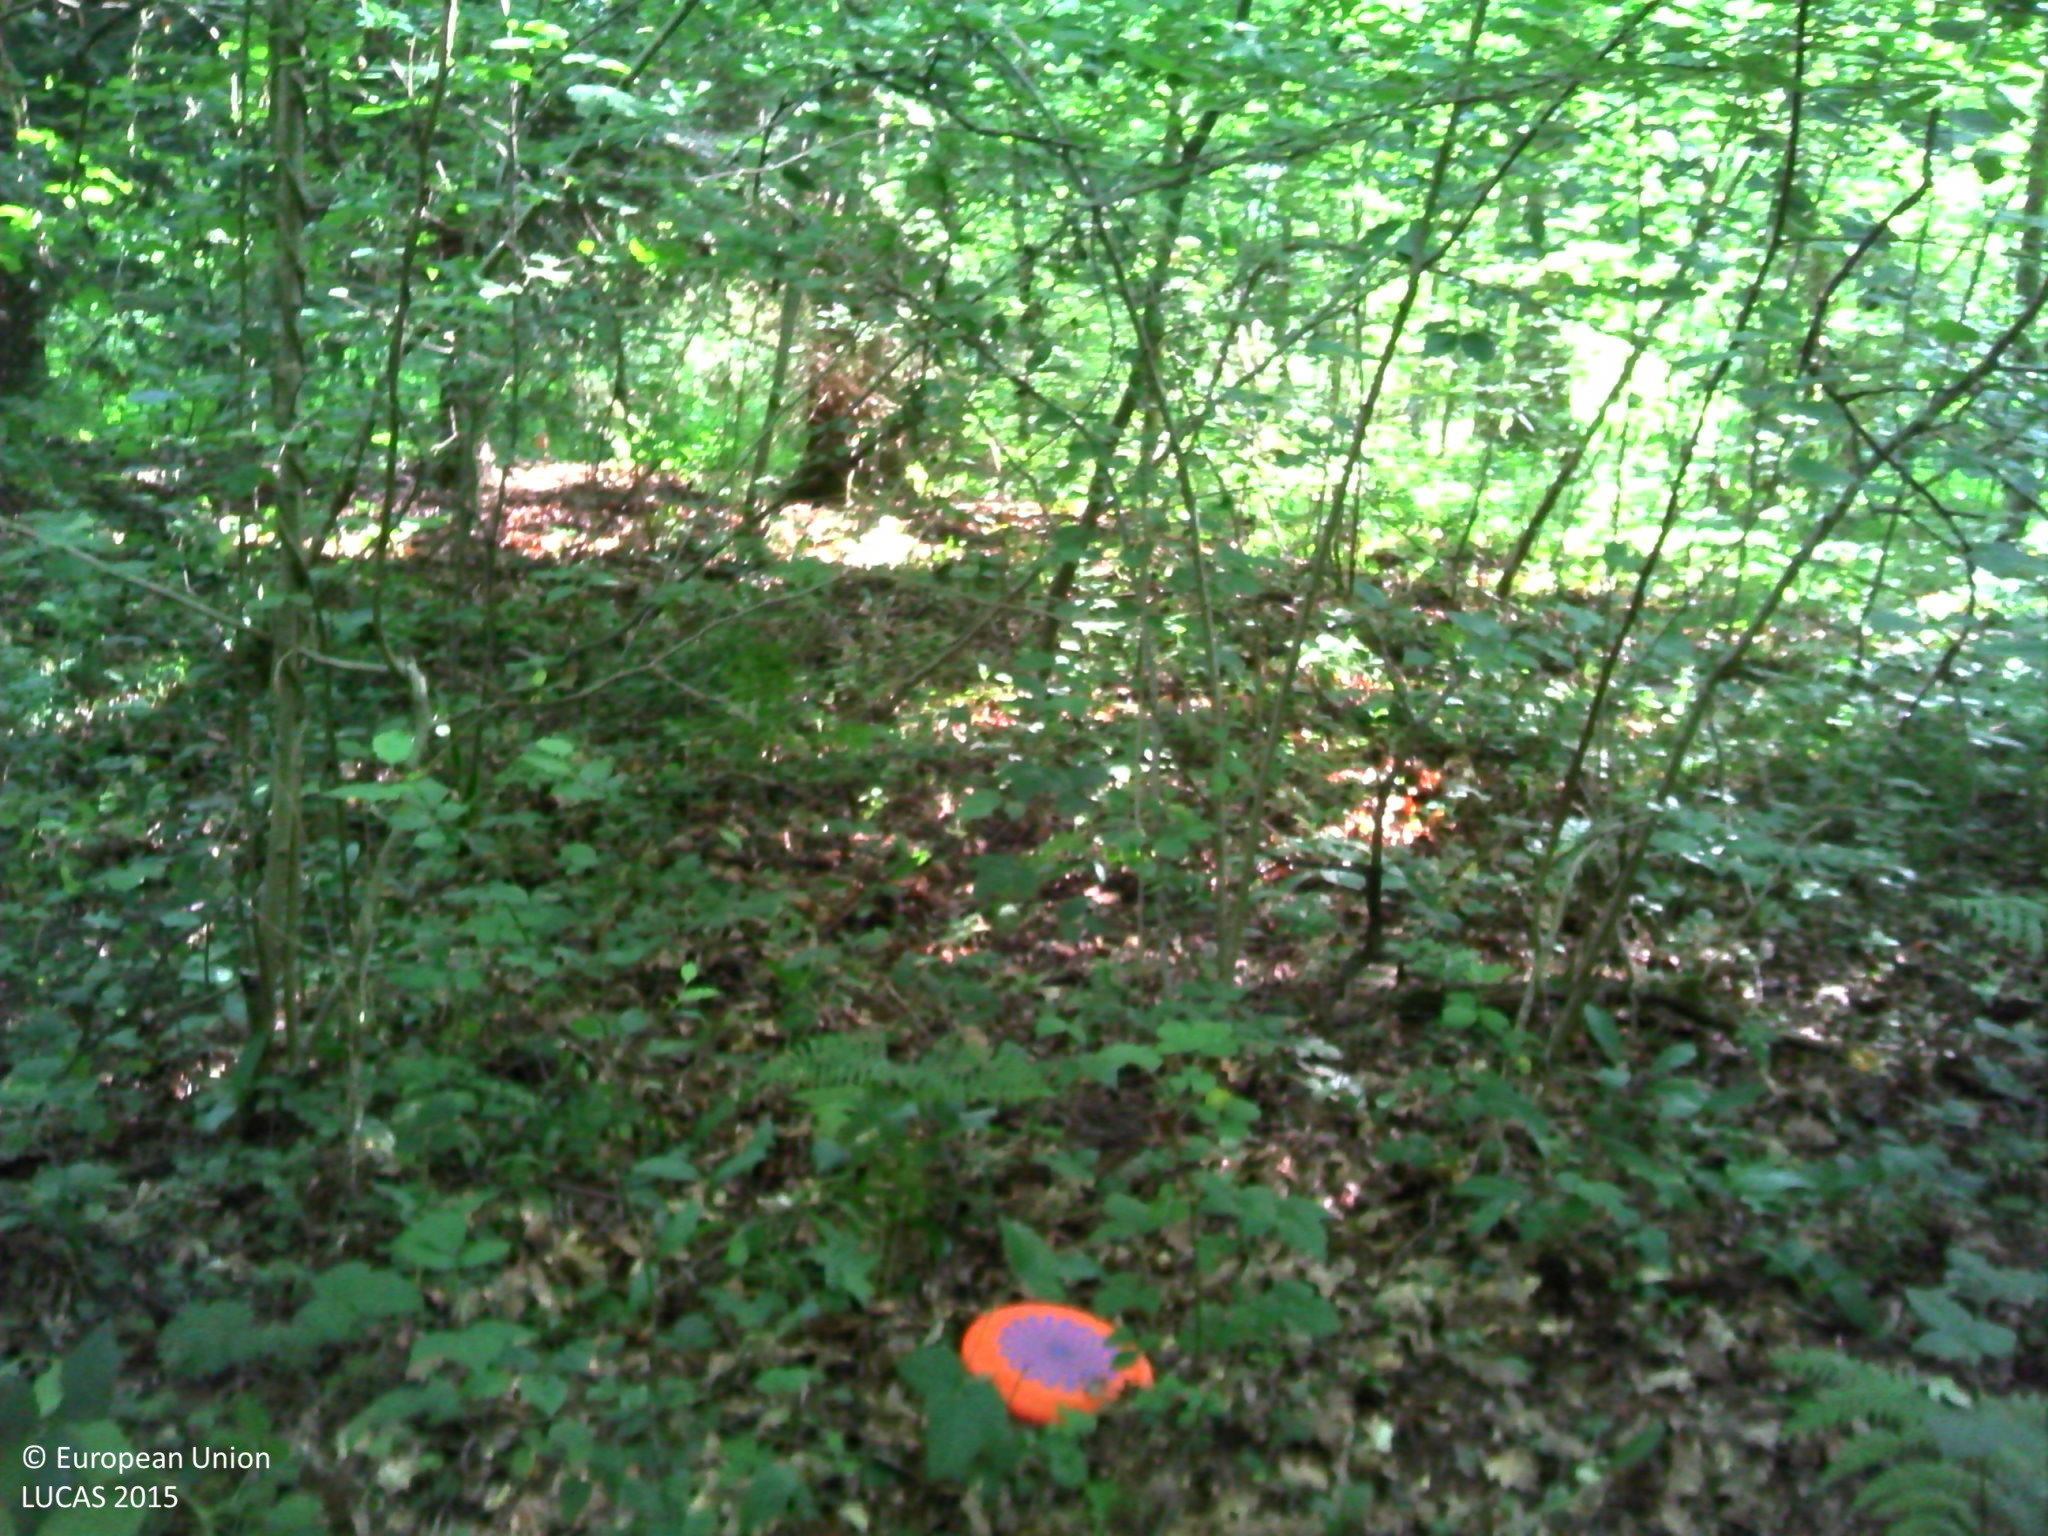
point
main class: Woodland
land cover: Broadleaved woodland
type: acidophilous oak and oak-birch forest
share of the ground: > 75 %
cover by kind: broadleaved forest trees 100 %
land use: Forestry
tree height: > 5 m
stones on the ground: < 10 %
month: July
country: BE
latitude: 50.2903
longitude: 4.5923
